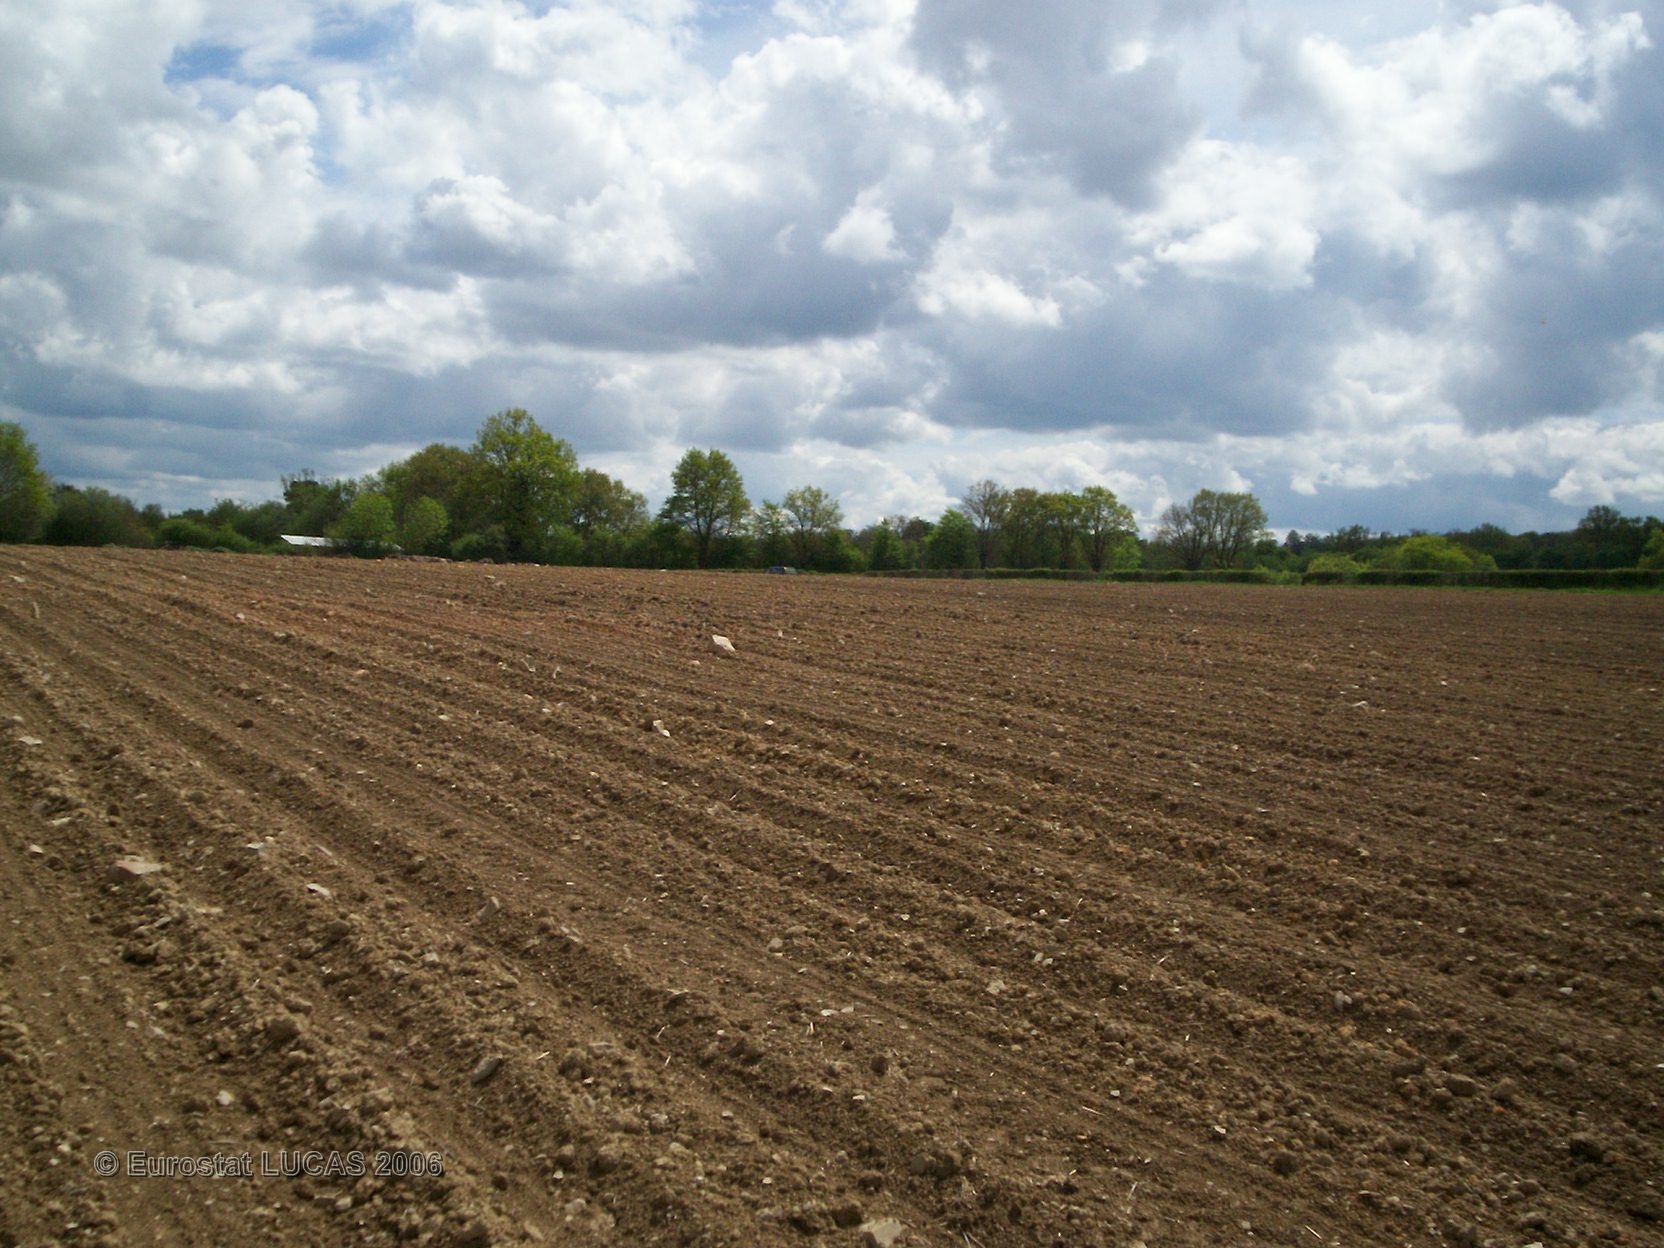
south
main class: Cropland
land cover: Maize
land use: Agriculture (excluding fallow land and kitchen gardens)
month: May
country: FR
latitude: 48.6246
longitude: 0.0532
